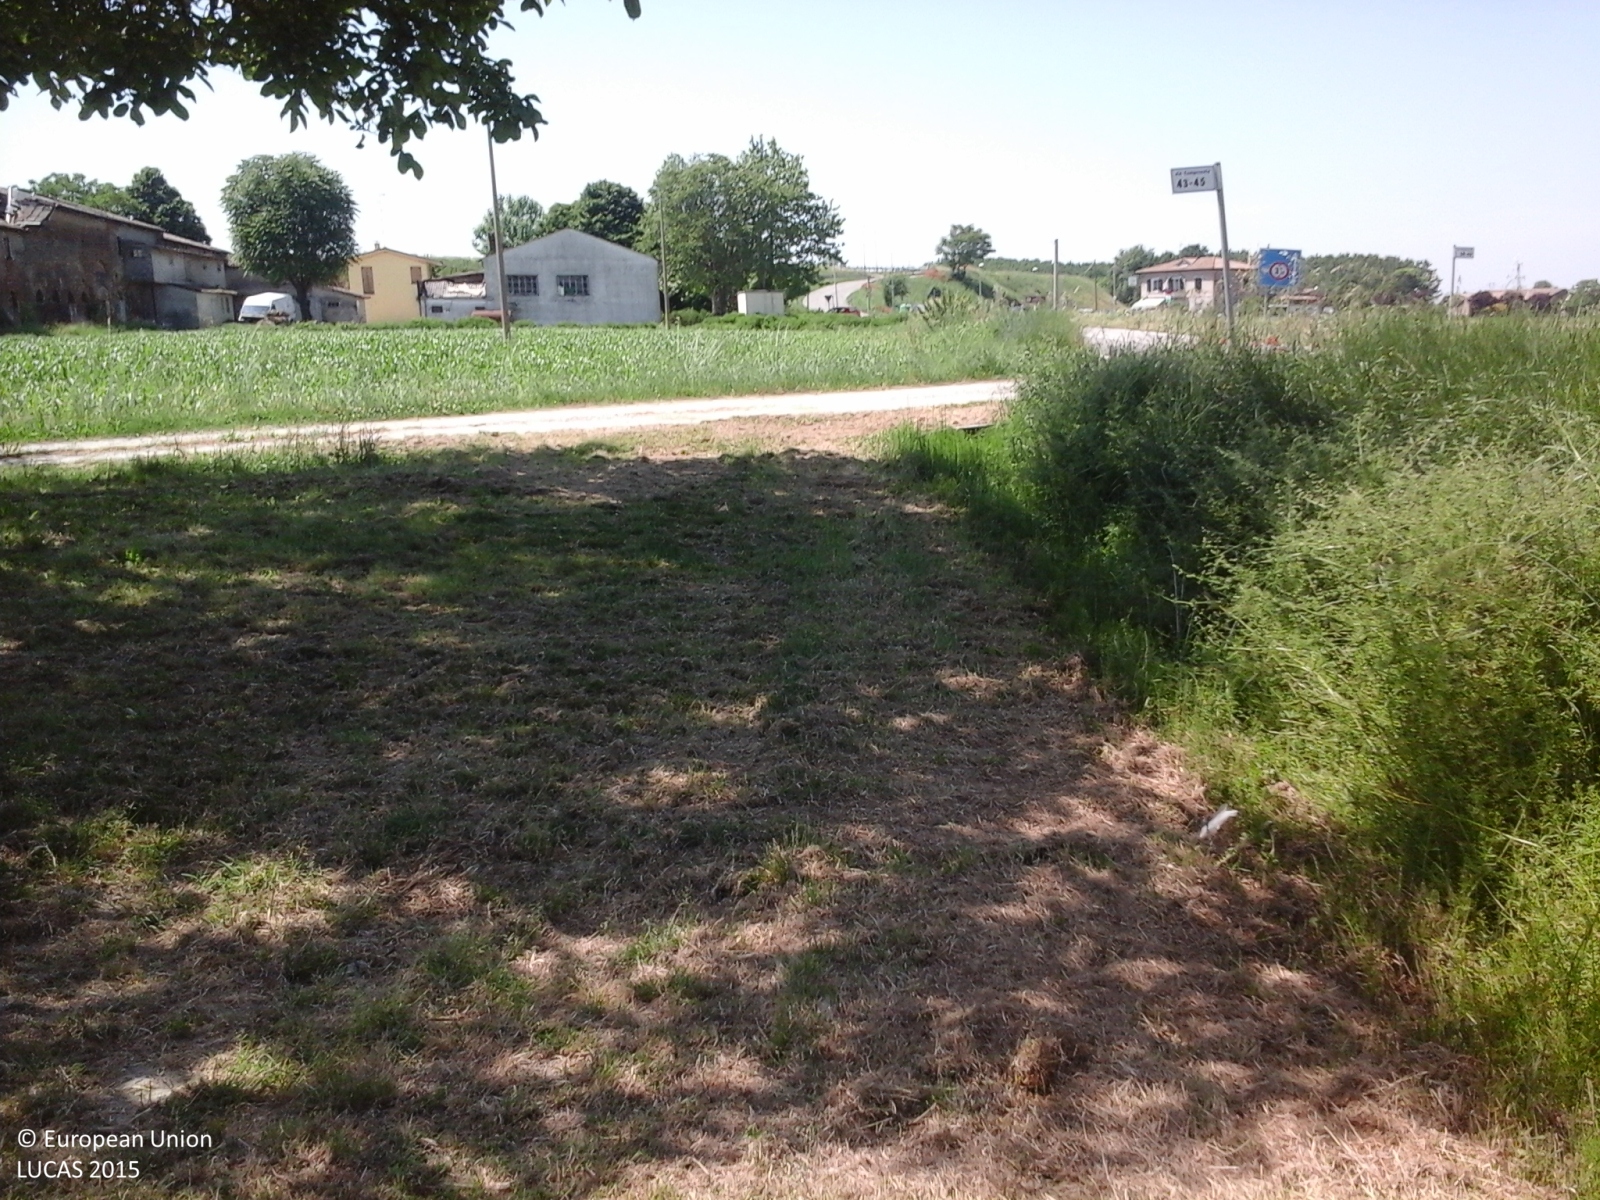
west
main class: Grassland
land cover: Grassland without tree/shrub cover
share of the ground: > 75 %
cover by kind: herbaceous plants 100 %
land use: Agriculture (excluding fallow land and kitchen gardens)
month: May
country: IT
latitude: 44.8122
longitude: 11.2241
